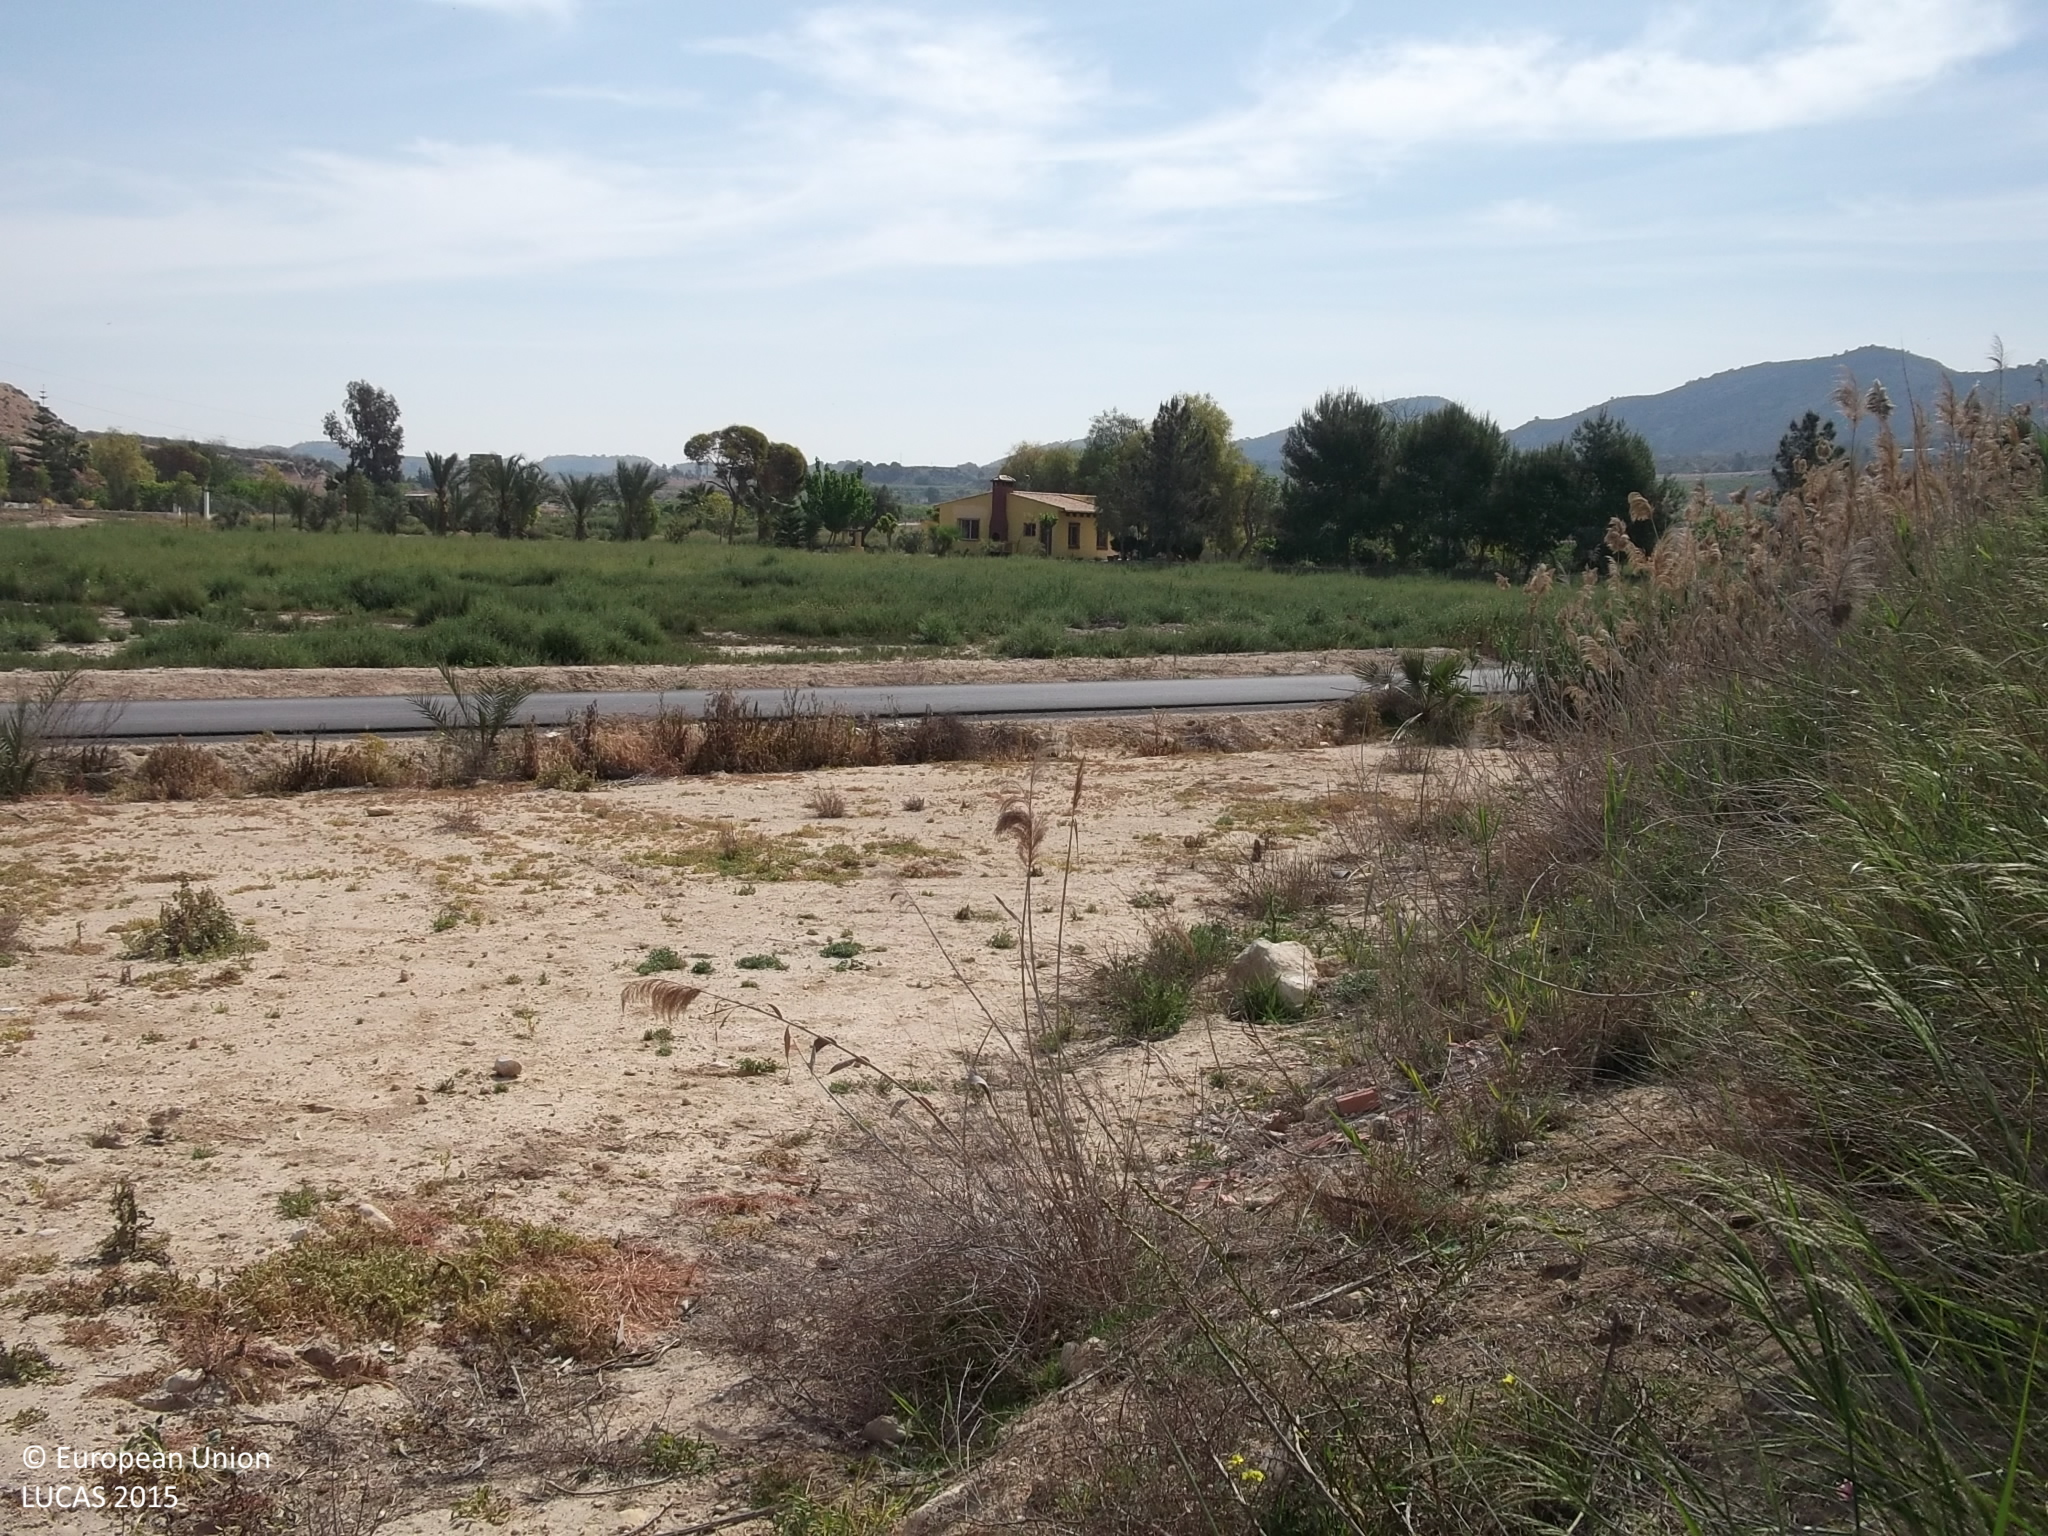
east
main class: Shrubland
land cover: Shrubland without tree cover
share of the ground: > 75 %
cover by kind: shrubs 85 %, herbaceous plants 15 %
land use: Abandoned areas
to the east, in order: Shrubland without tree cover; Spontaneously vegetated surfaces; Grass margins; Paved roads, cycling and walking lanes; Grass margins; Shrubland without tree cover; Spontaneously vegetated surfaces; Single bushes/trees; Shrubland without tree cover; Fences; Tracks; Other bare soil; Grass margins
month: April
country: ES
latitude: 38.0243
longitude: -0.9766
